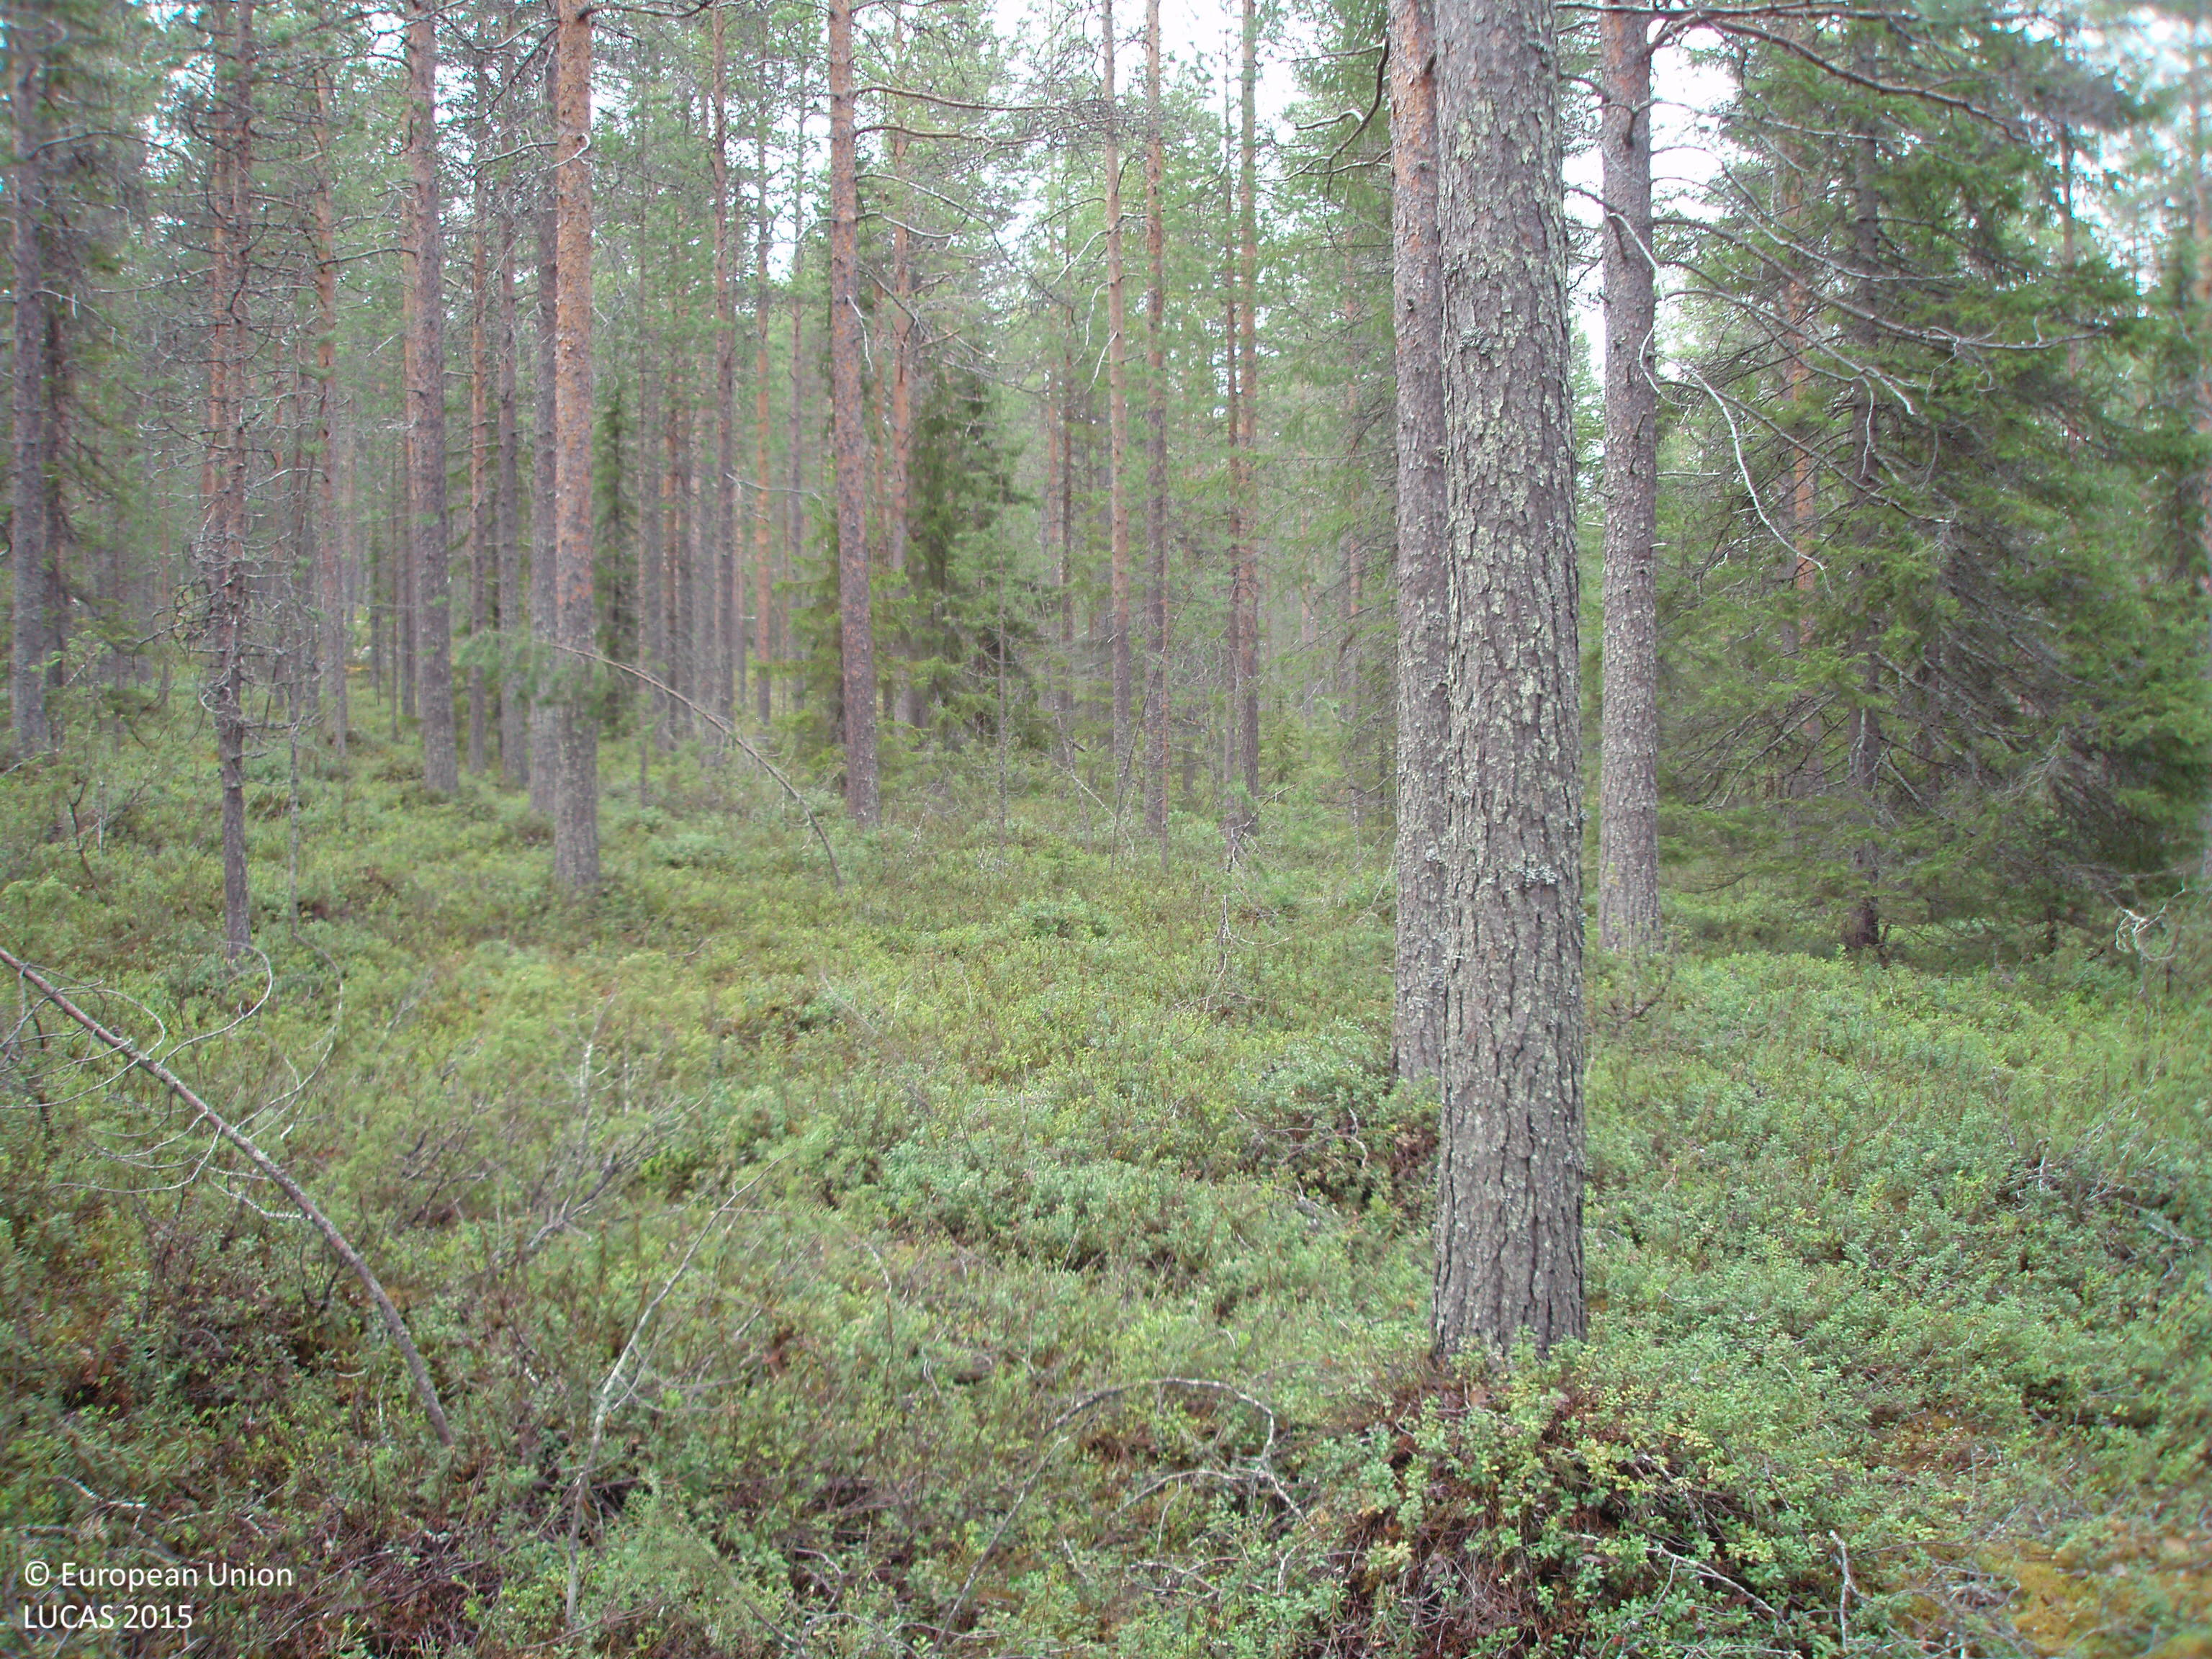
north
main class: Woodland
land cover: Pine dominated coniferous woodland
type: boreal forest
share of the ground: > 75 %
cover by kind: coniferous forest trees 85 %, shrubs 15 %
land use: Forestry
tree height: > 5 m
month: June
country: FI
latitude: 66.7038
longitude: 27.5837
